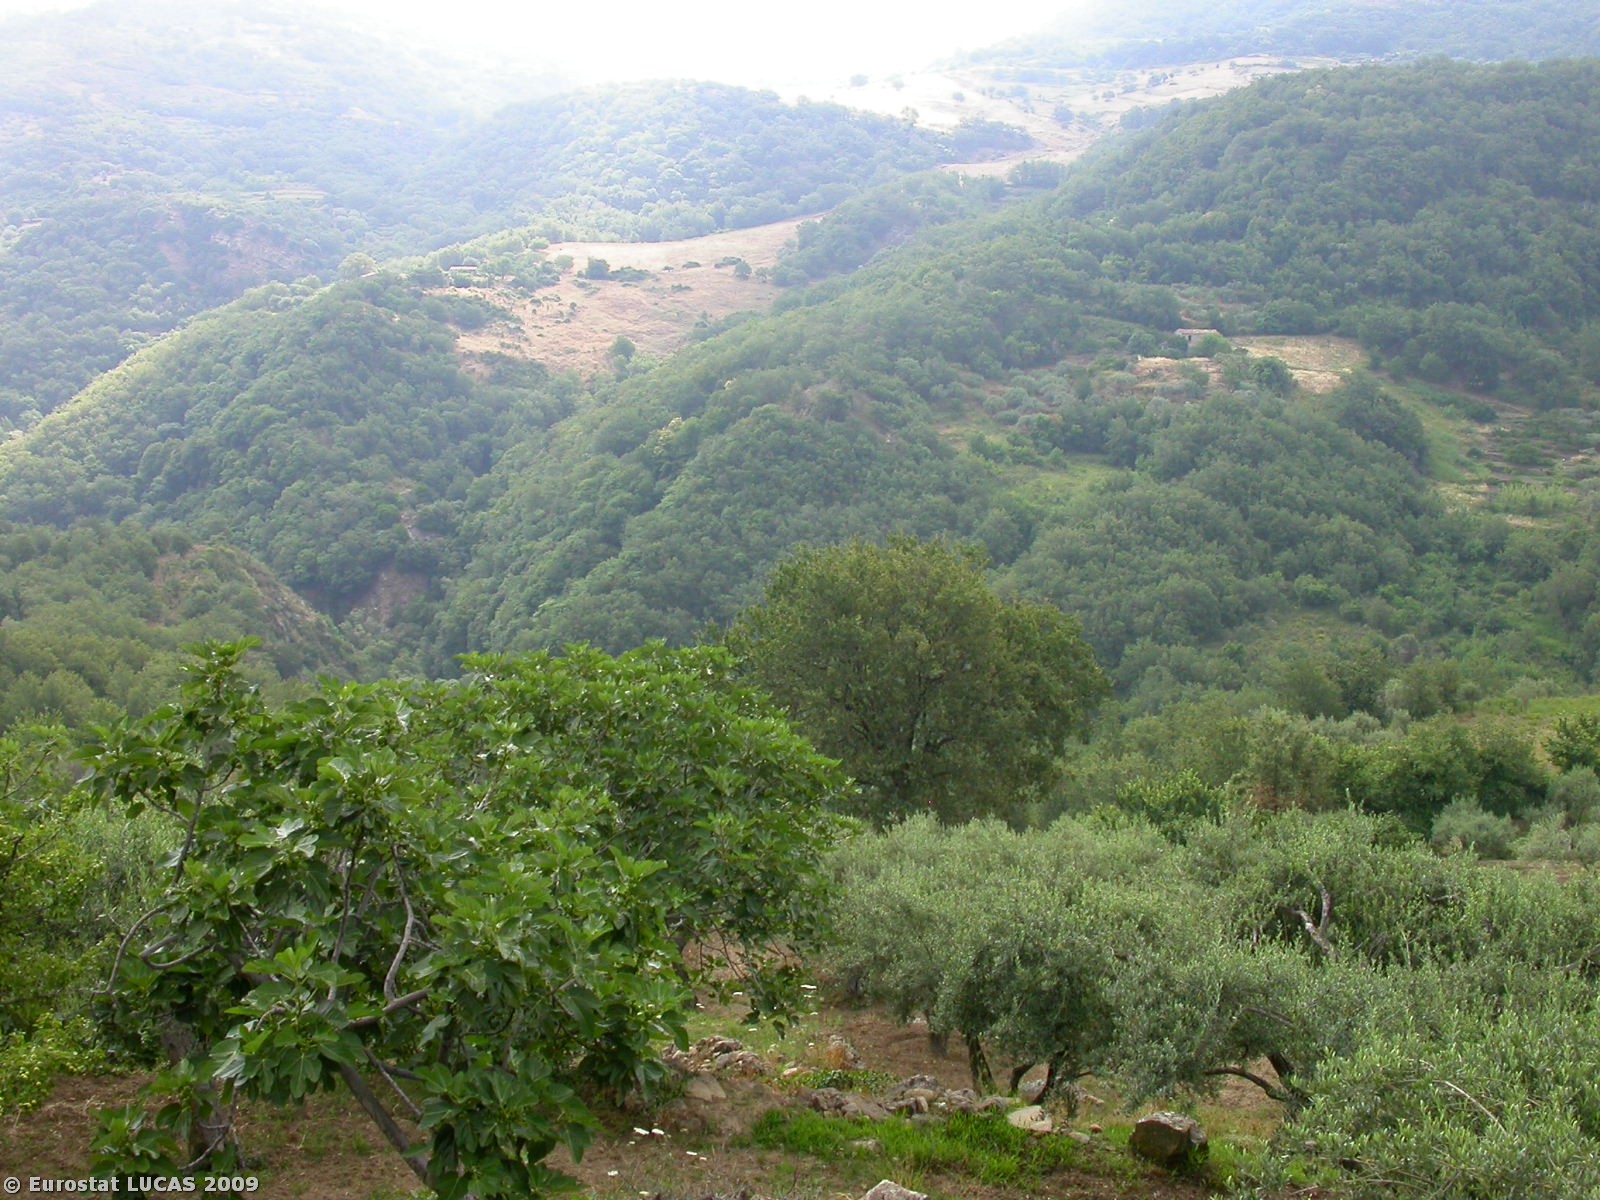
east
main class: Cropland
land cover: Olive groves
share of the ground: 50 - 75 %
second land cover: Bare land
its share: > 75 %
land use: Agriculture (excluding fallow land and kitchen gardens)
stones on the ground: 10 - 25 %
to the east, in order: Olive groves; Bare land; Tracks; Olive groves; Bare land; Tracks; Olive groves; Bare land
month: June
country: IT
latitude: 38.0515
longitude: 15.0153
